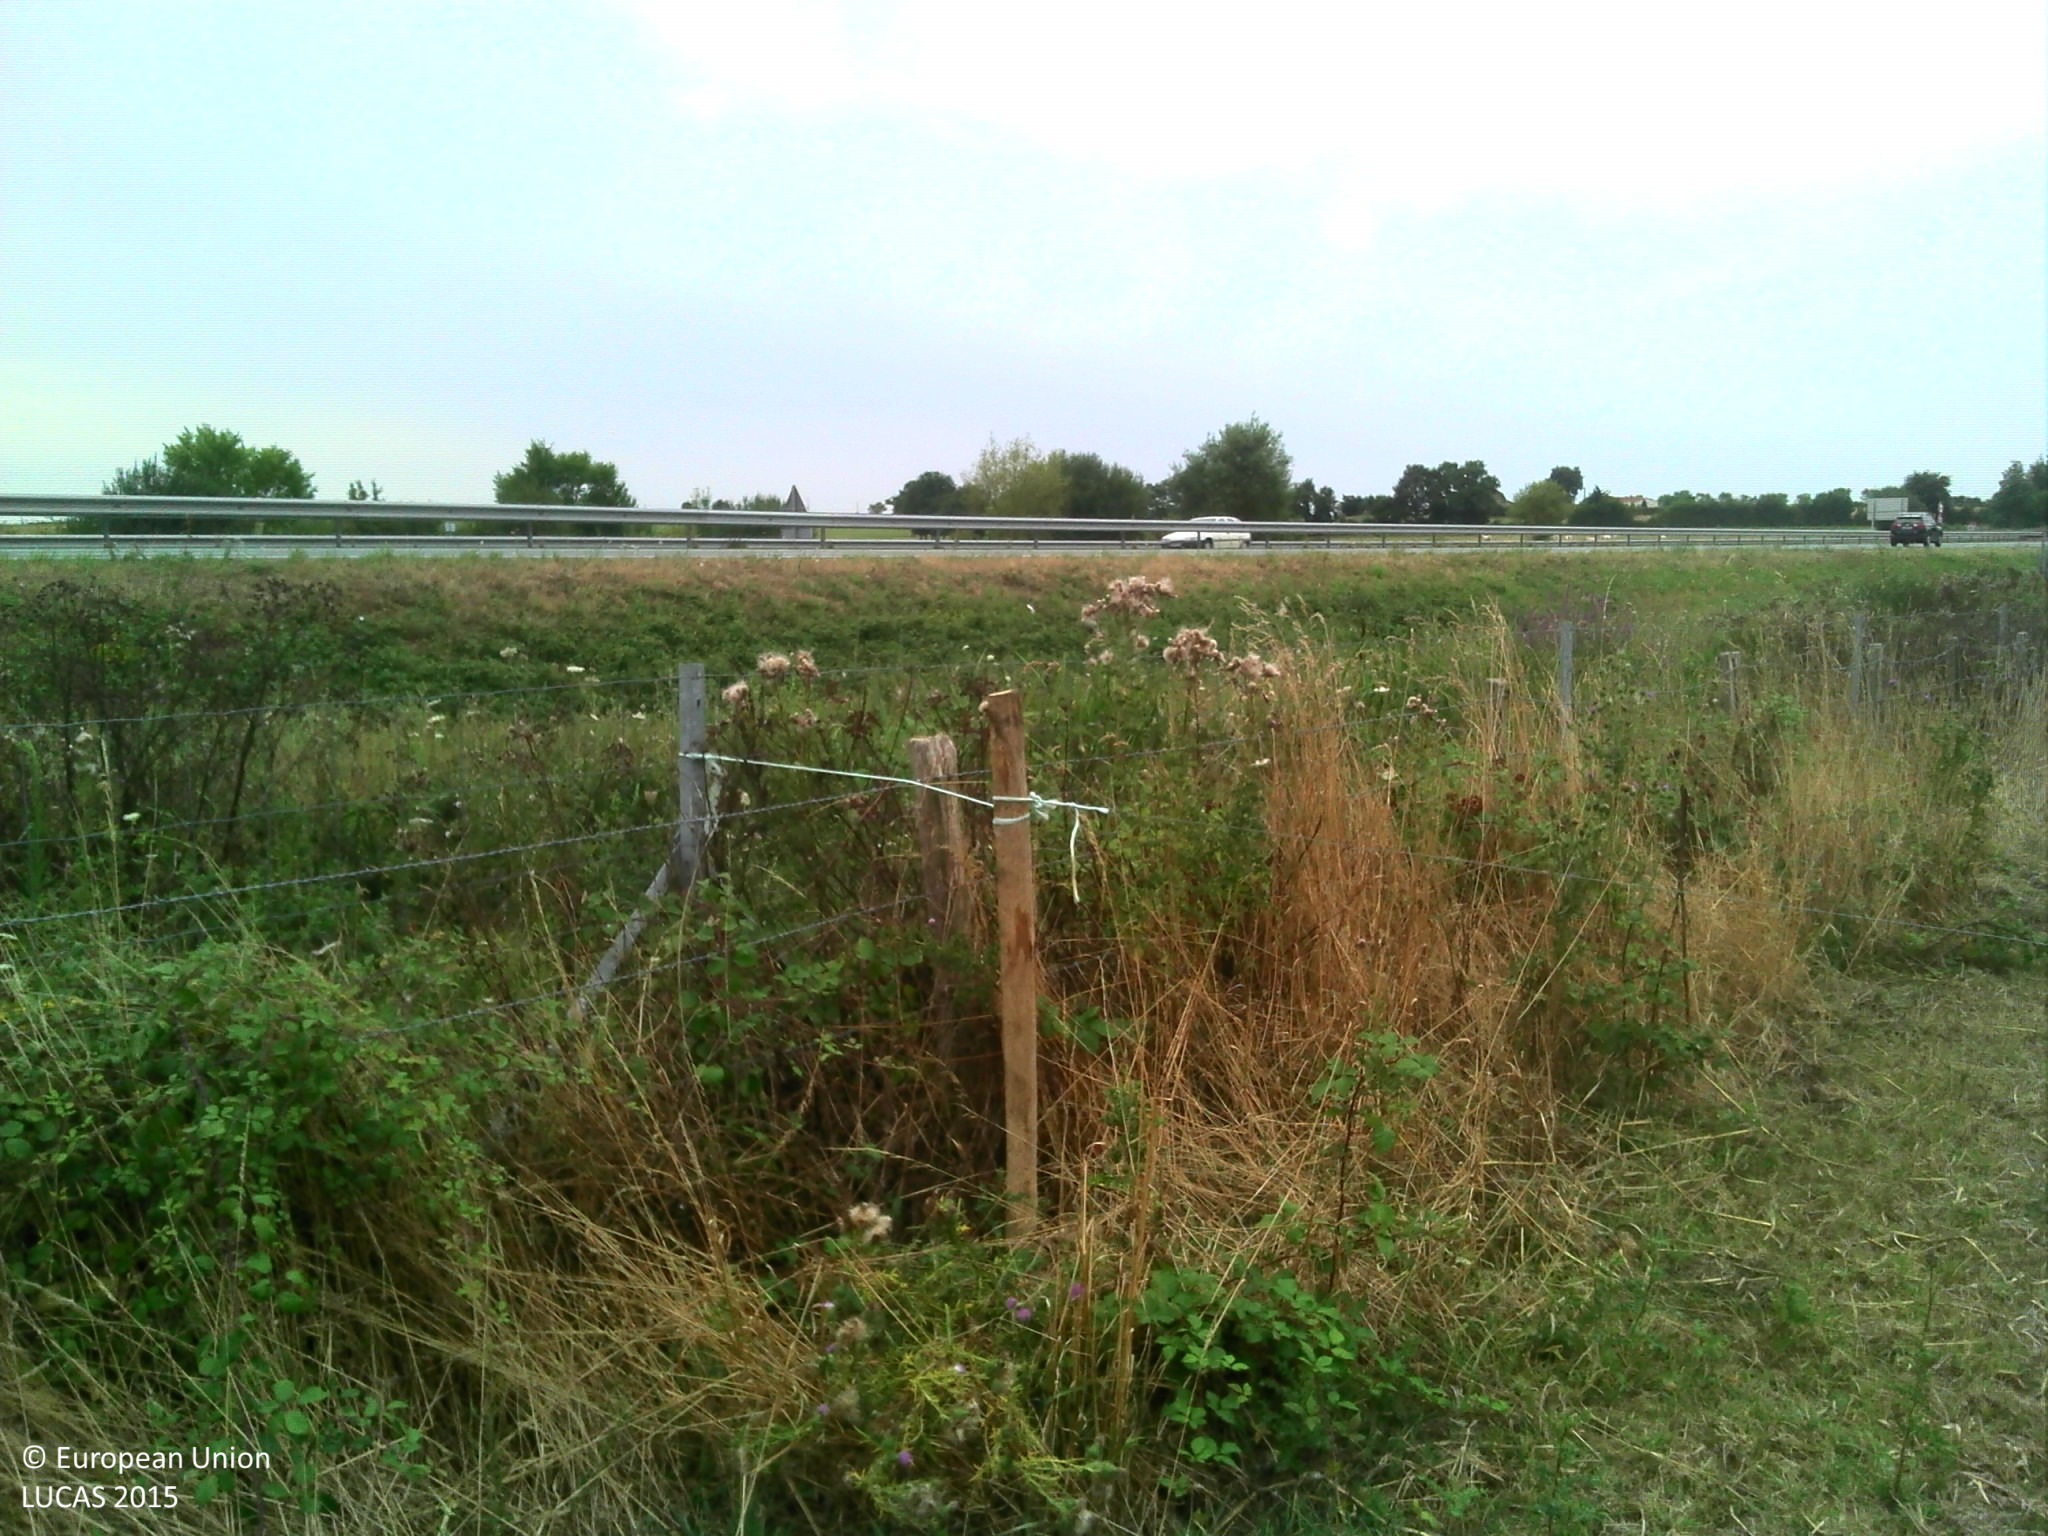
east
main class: Cropland
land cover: Temporary grasslands
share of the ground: > 75 %
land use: Agriculture (excluding fallow land and kitchen gardens)
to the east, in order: Temporary grasslands; Fences; Ditches and canals; Grassland without tree/shrub cover; Paved roads, cycling and walking lanes; Grassland without tree/shrub cover; Ditches and canals; Grassland with sparse tree/shrub cover; Fences; Lines of trees; Ditches and canals; Grass margins; Tracks; Grass margins; Lines of trees; Maize
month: July
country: FR
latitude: 46.8162
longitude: -1.1891
